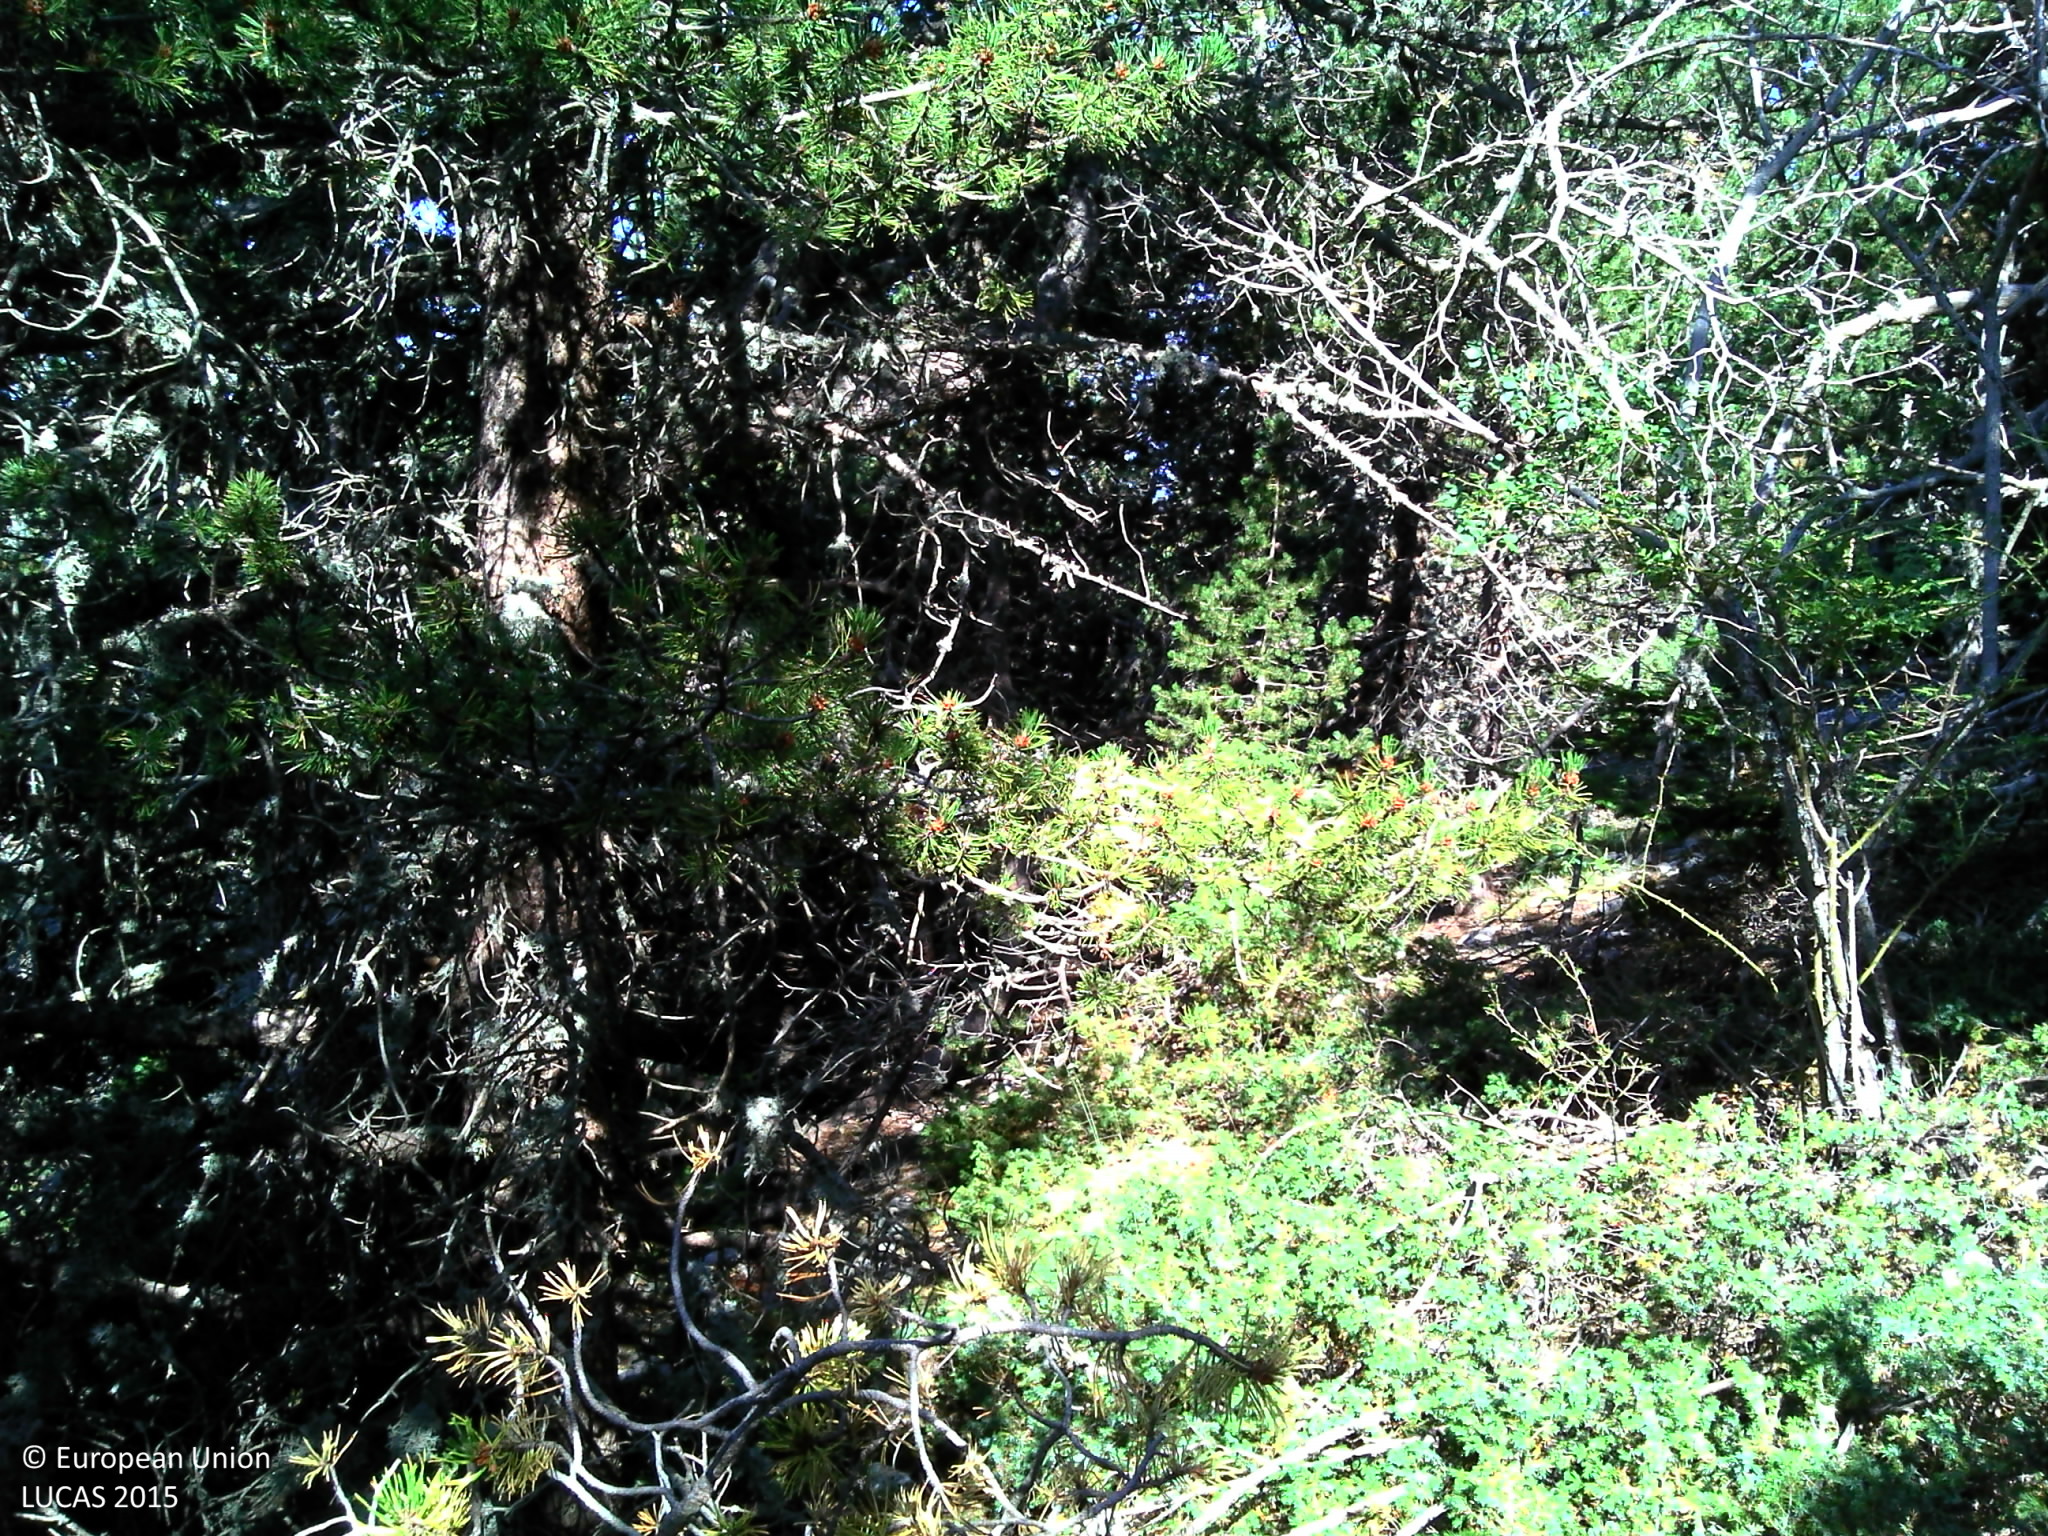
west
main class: Woodland
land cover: Other coniferous woodland
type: coniferous forest of the mediterranean region
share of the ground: > 75 %
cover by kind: coniferous forest trees 45 %, lichens and mosses 15 %, unconsolidated bare surface 15 %, shrubs 10 %, herbaceous plants 10 %, broadleaved forest trees 5 %
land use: Semi-natural and natural areas not in use
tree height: > 5 m
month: July
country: FR
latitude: 44.1692
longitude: 5.2430
